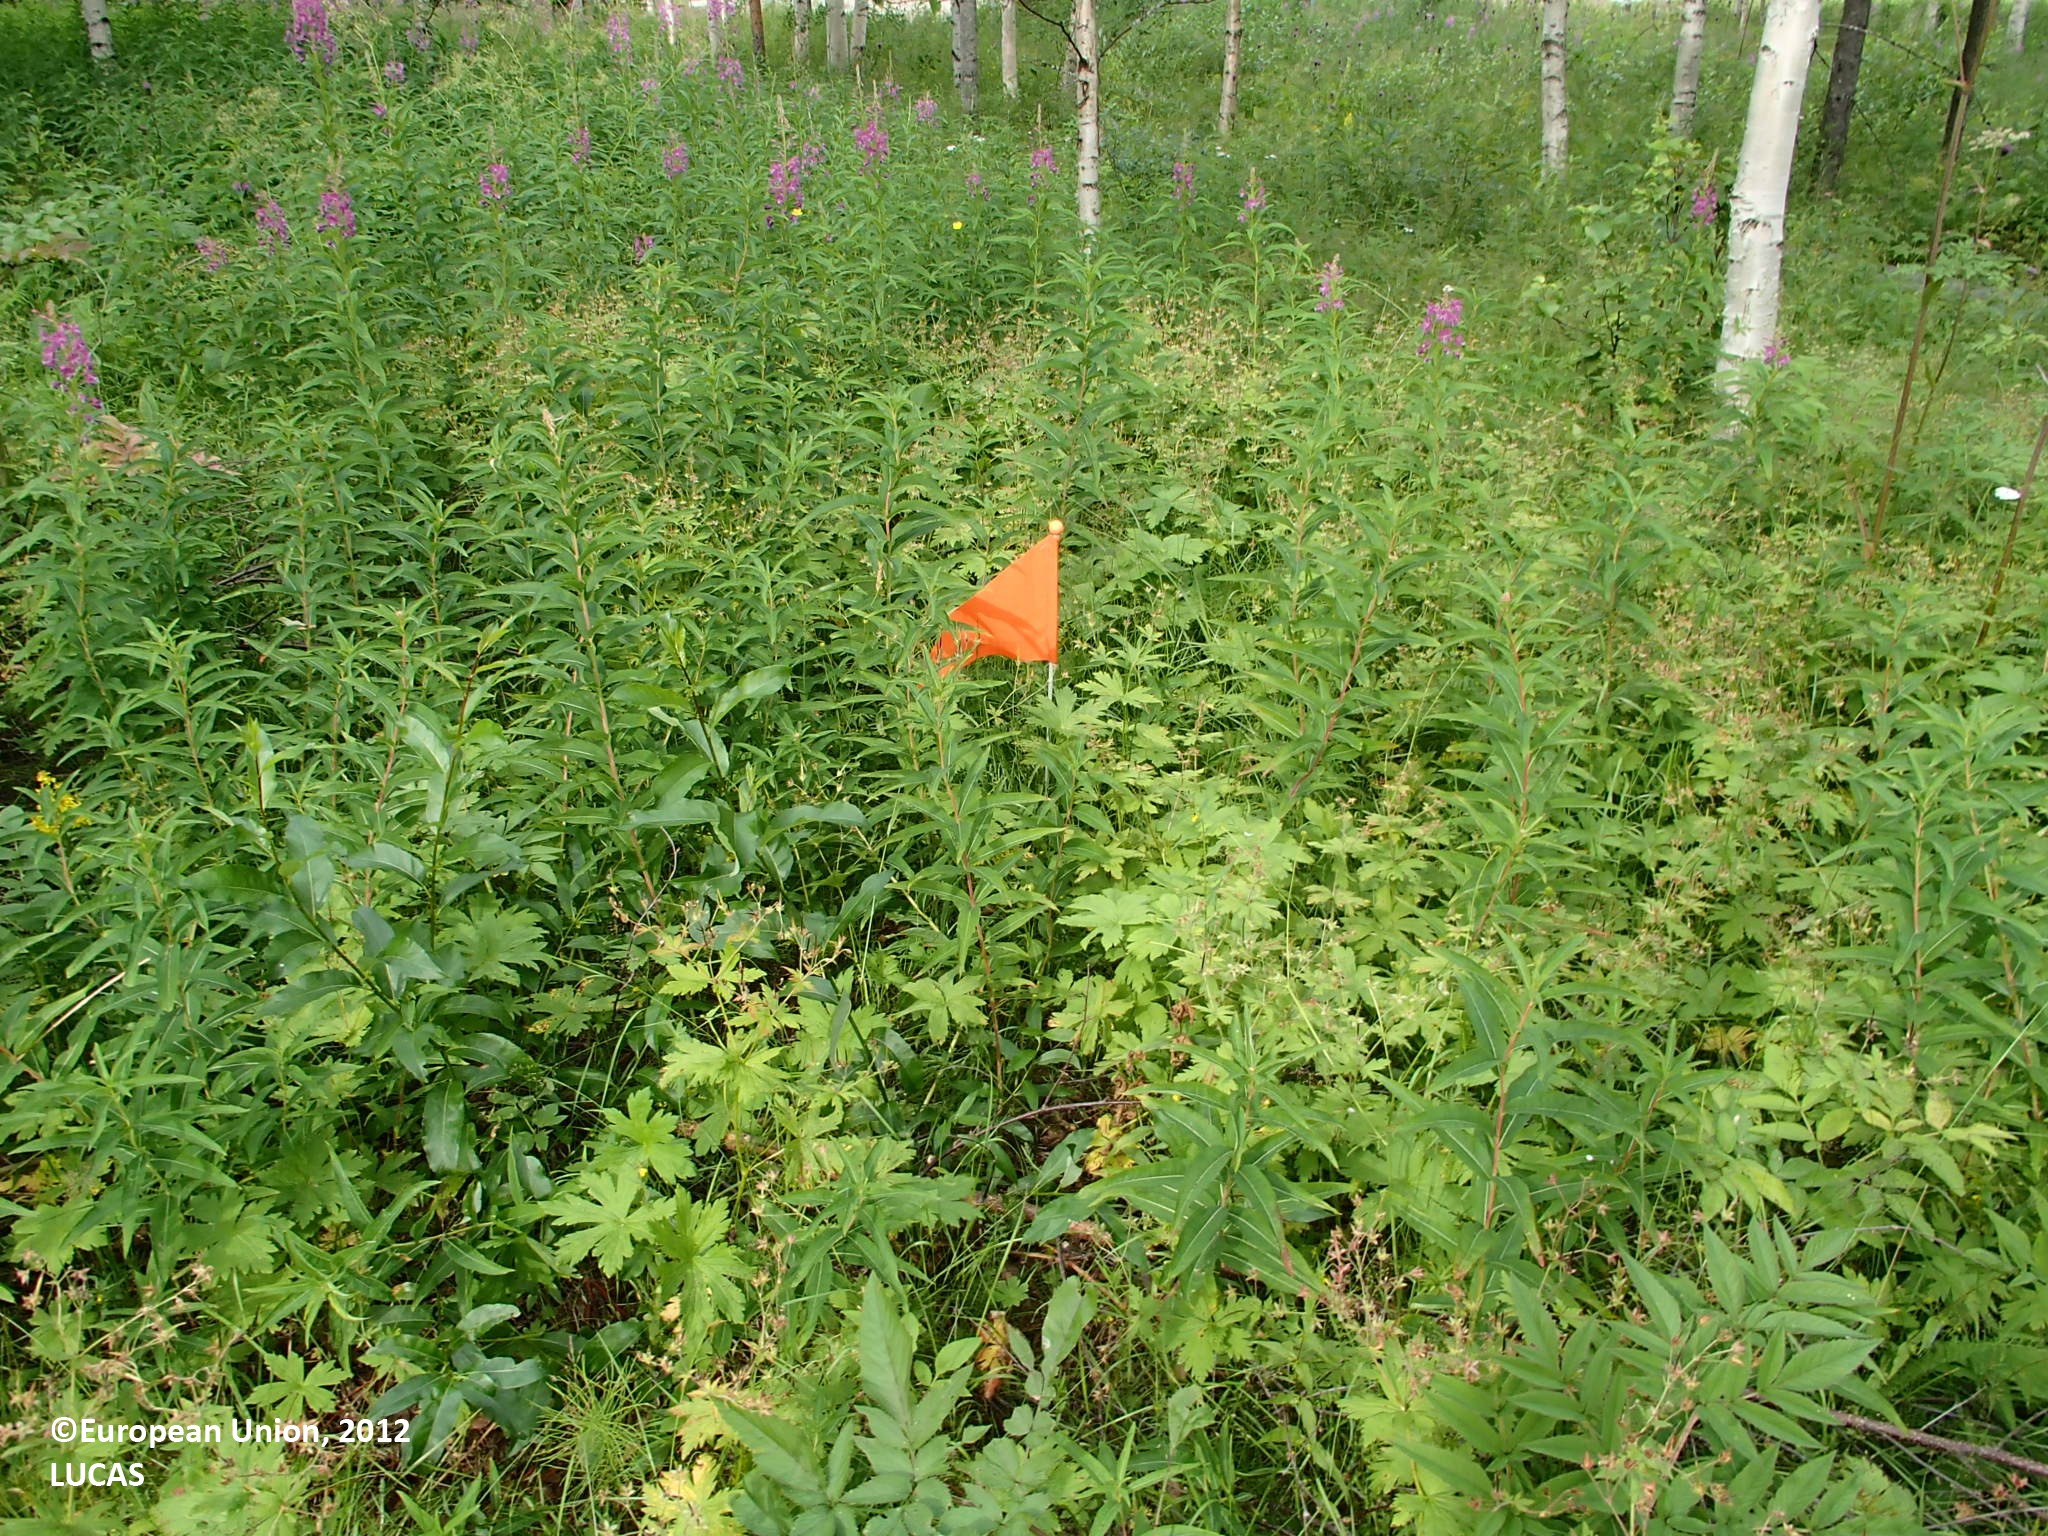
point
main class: Woodland
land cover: Broadleaved woodland
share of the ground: > 75 %
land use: Forestry
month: July
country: FI
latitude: 66.3800
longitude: 25.3842
